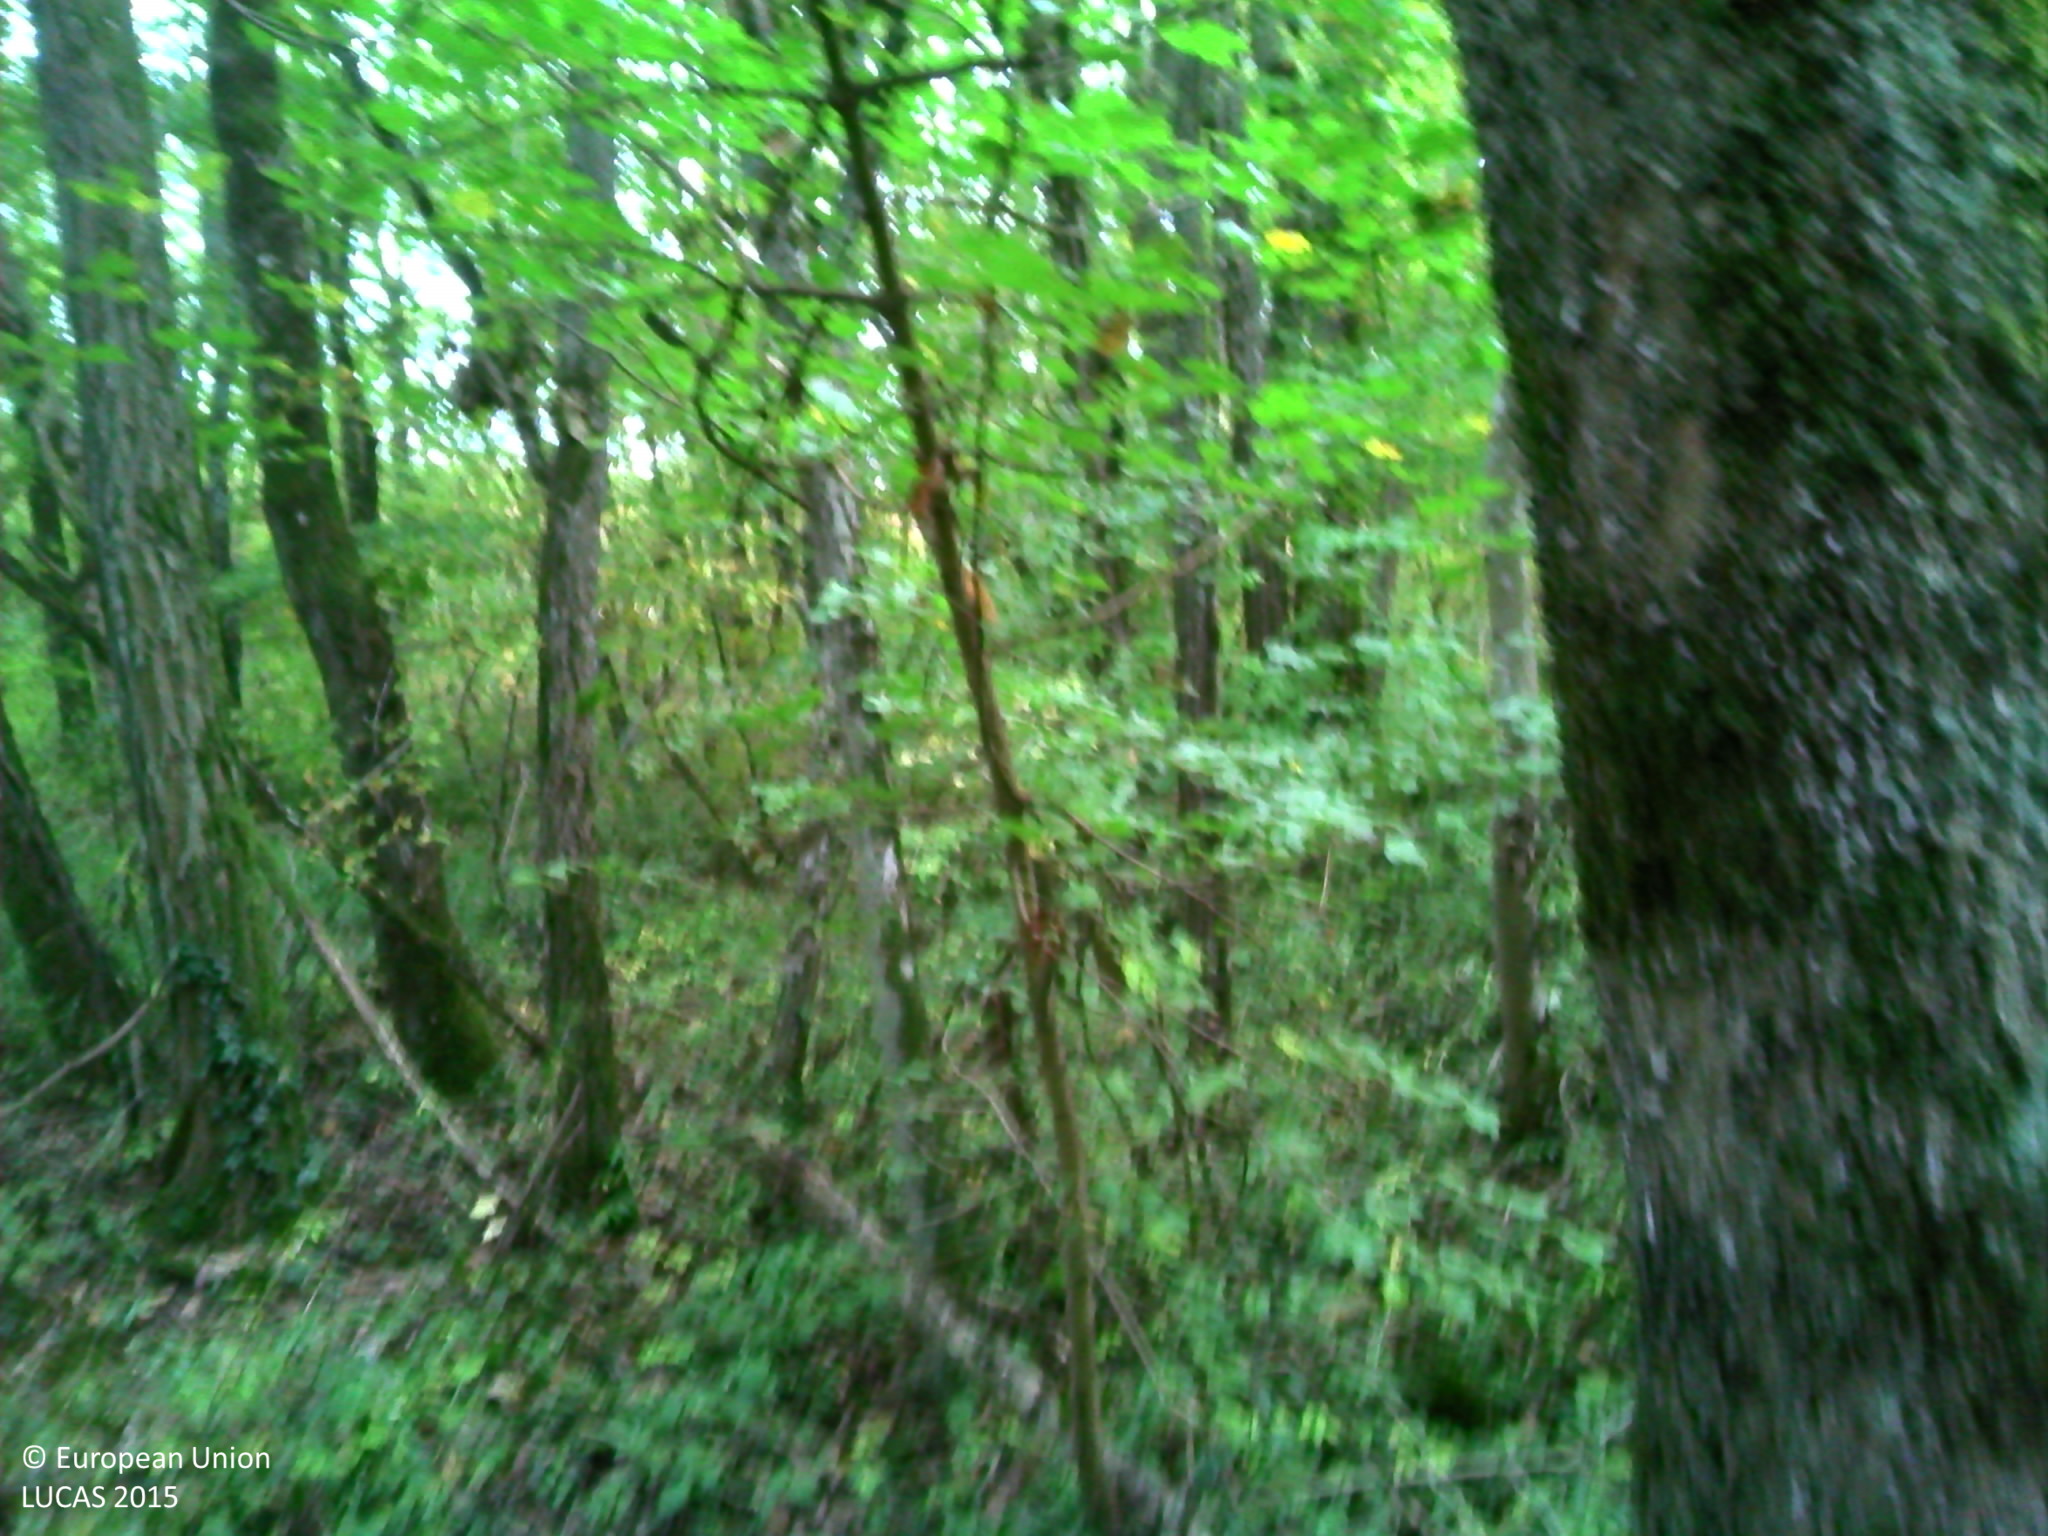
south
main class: Woodland
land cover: Broadleaved woodland
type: mesophytic deciduous forest
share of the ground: > 75 %
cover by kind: broadleaved forest trees 100 %
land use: Semi-natural and natural areas not in use
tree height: > 5 m
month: October
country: FR
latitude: 47.1724
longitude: 5.0004
